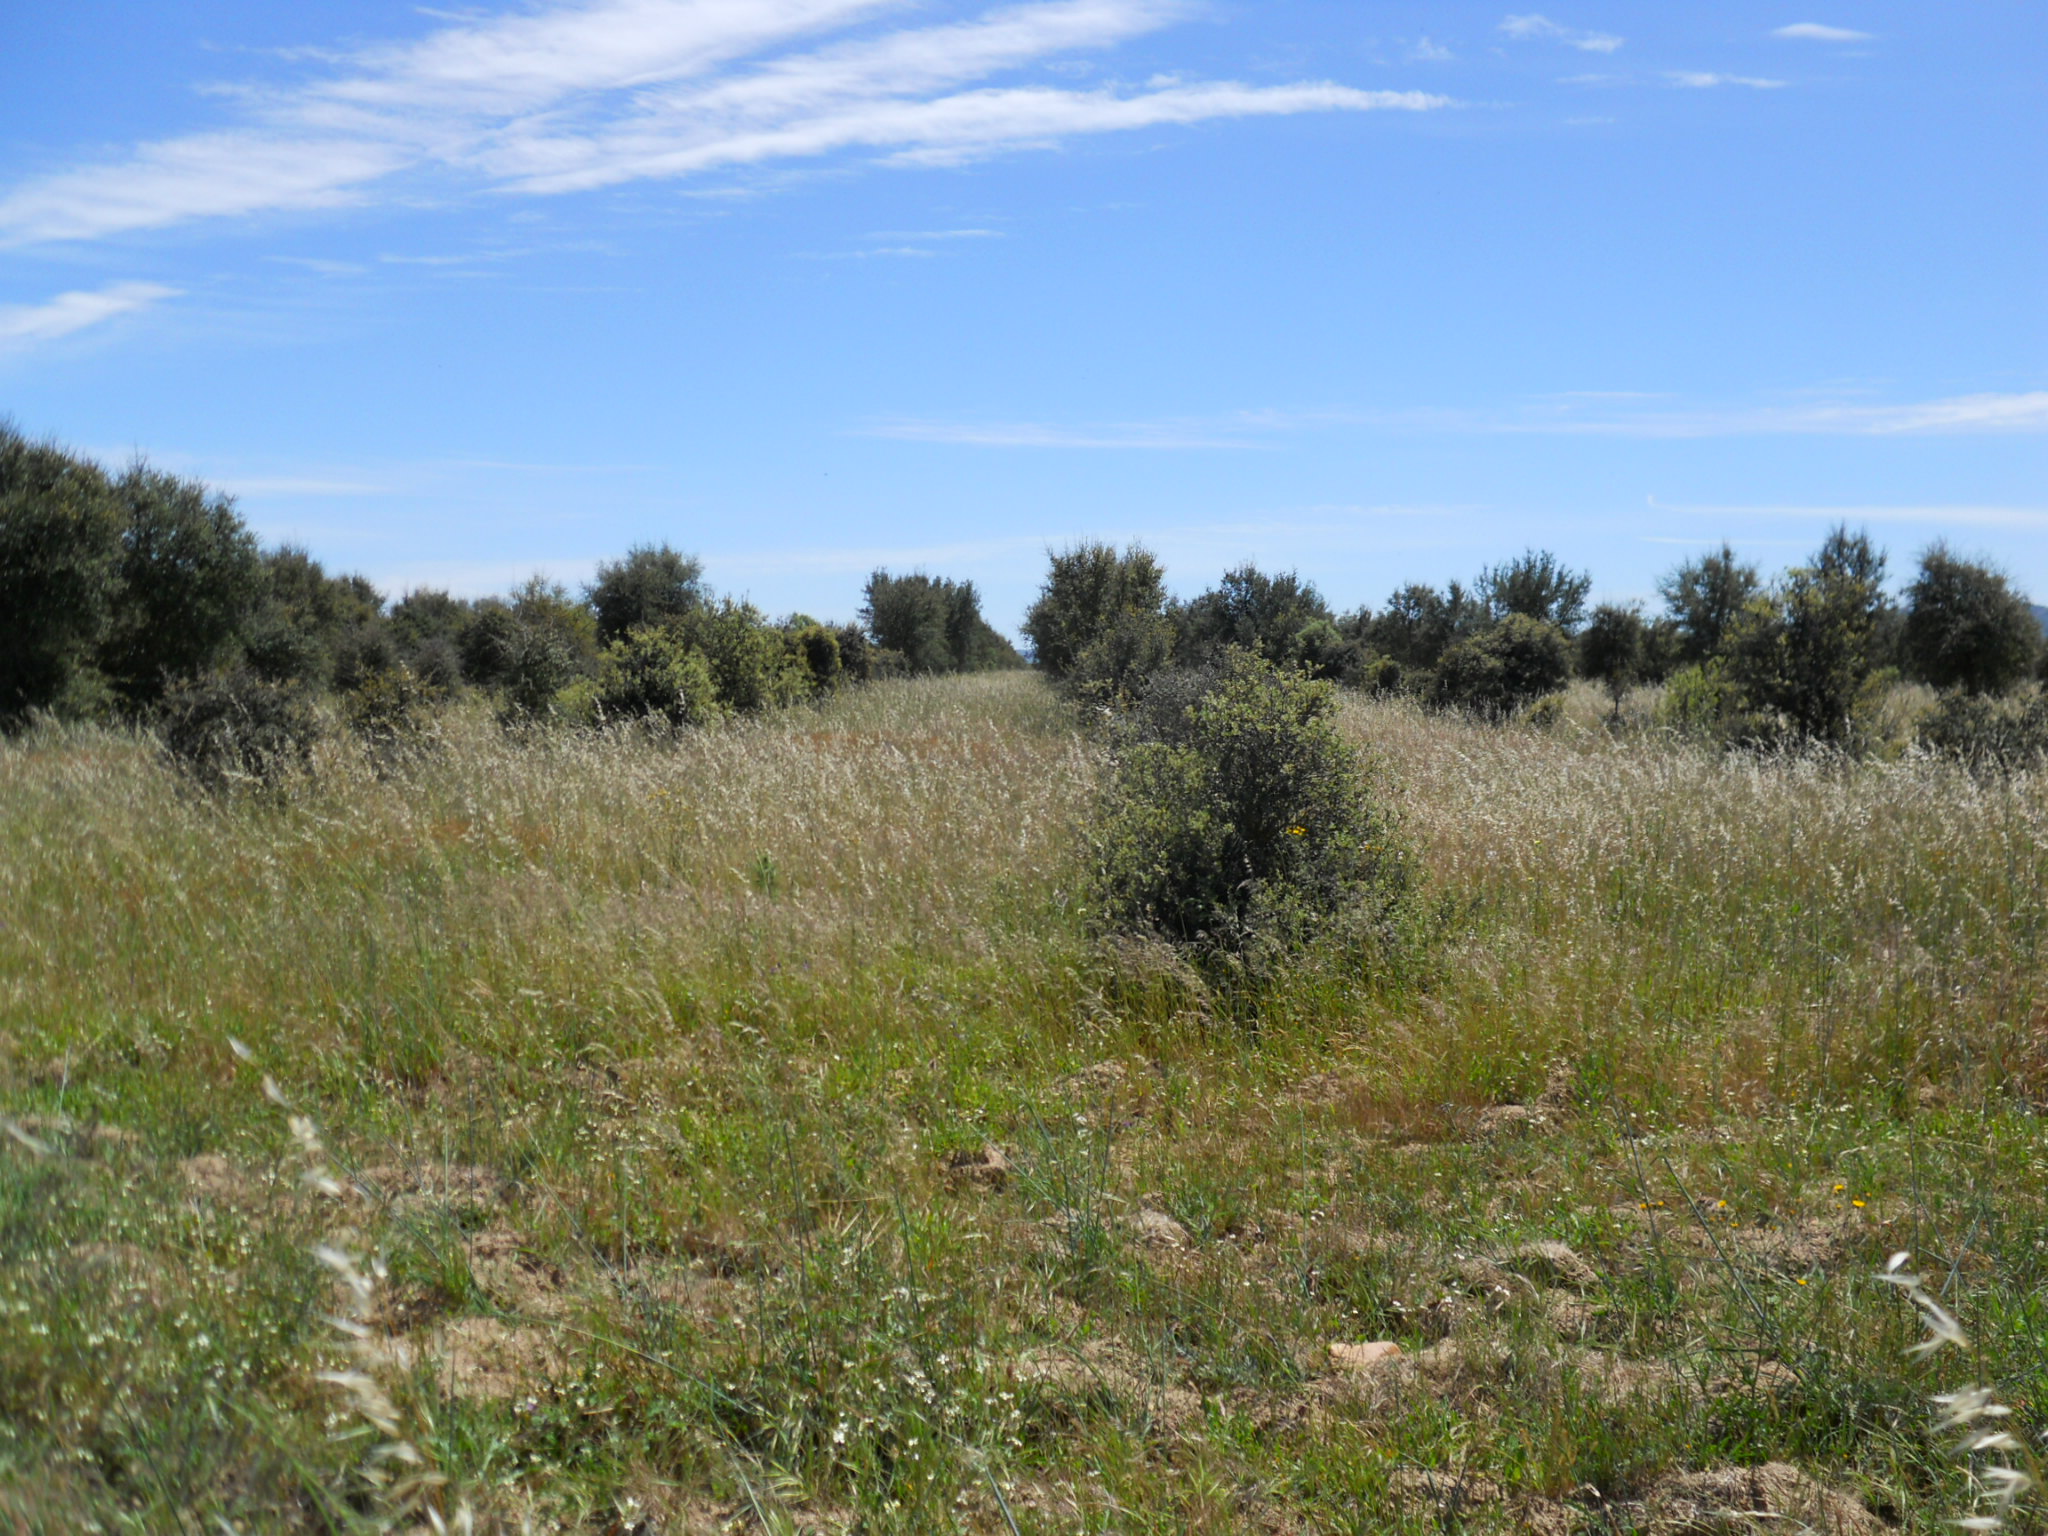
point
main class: Woodland
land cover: Broadleaved woodland
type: broadleaved evergreen forest
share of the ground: 25 - 50 %
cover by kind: broadleaved forest trees 80 %, herbaceous plants 20 %
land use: Forestry
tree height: < 5 m
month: May
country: ES
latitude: 39.2583
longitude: -6.3225
